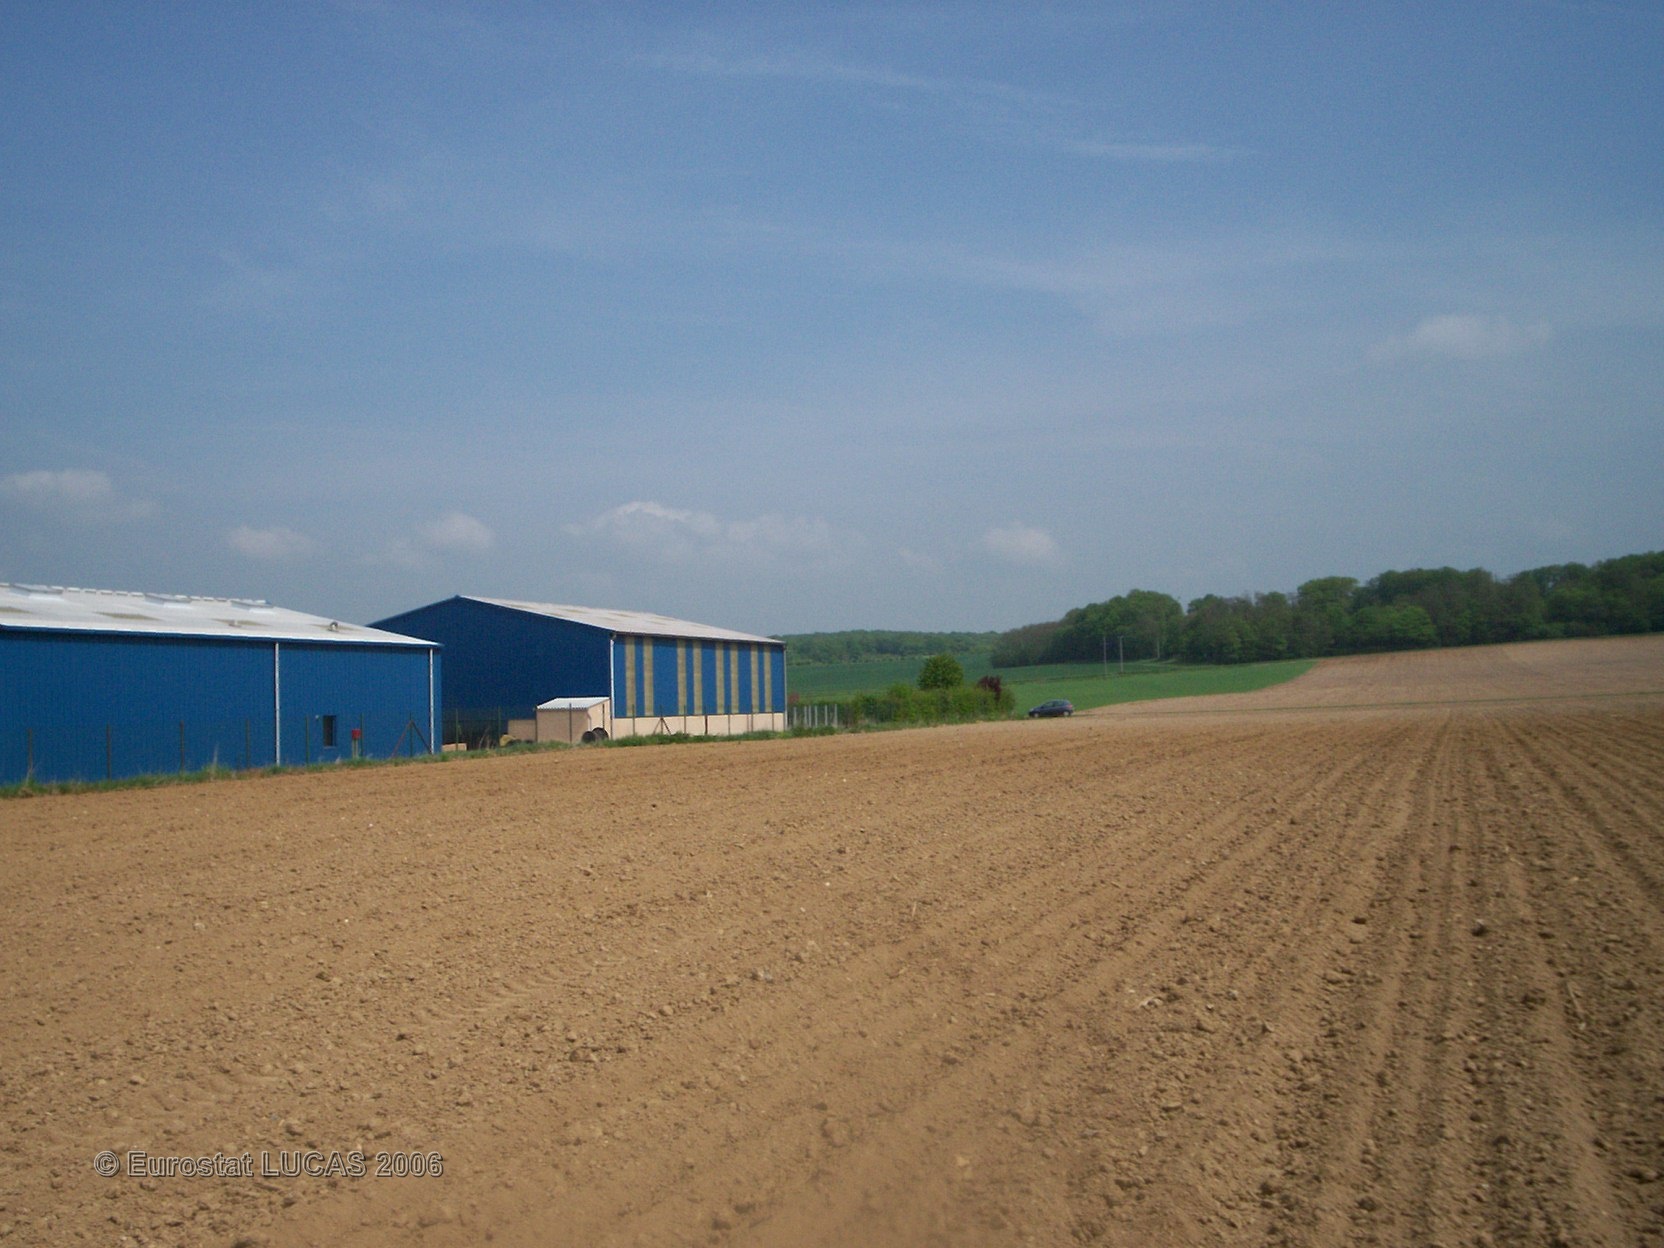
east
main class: Cropland
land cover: Maize
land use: Agriculture (excluding fallow land and kitchen gardens)
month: May
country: FR
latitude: 47.9248
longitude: 2.9399
